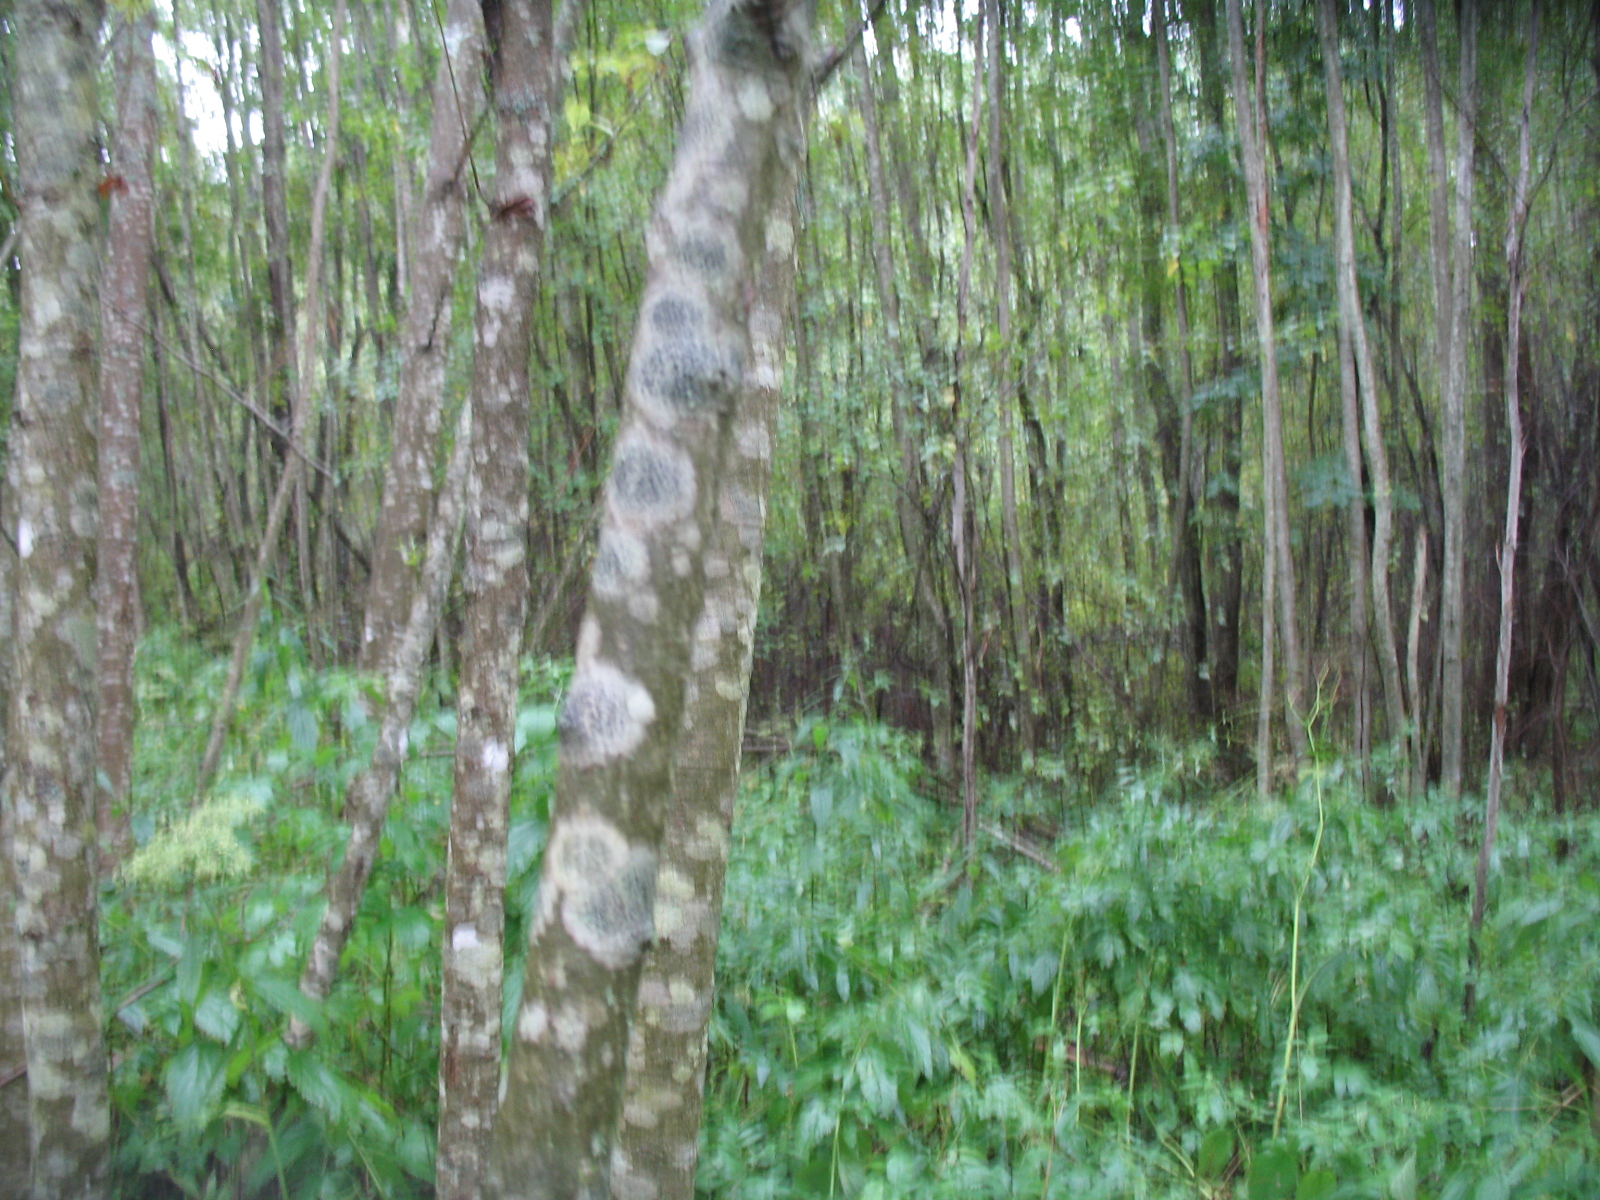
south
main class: Woodland
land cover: Broadleaved woodland
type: non-riverine alder, birch or aspen forest
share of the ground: > 75 %
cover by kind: broadleaved forest trees 90 %, herbaceous plants 10 %
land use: Forestry
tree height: > 5 m
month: September
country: LV
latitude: 56.0230
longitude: 25.9706
